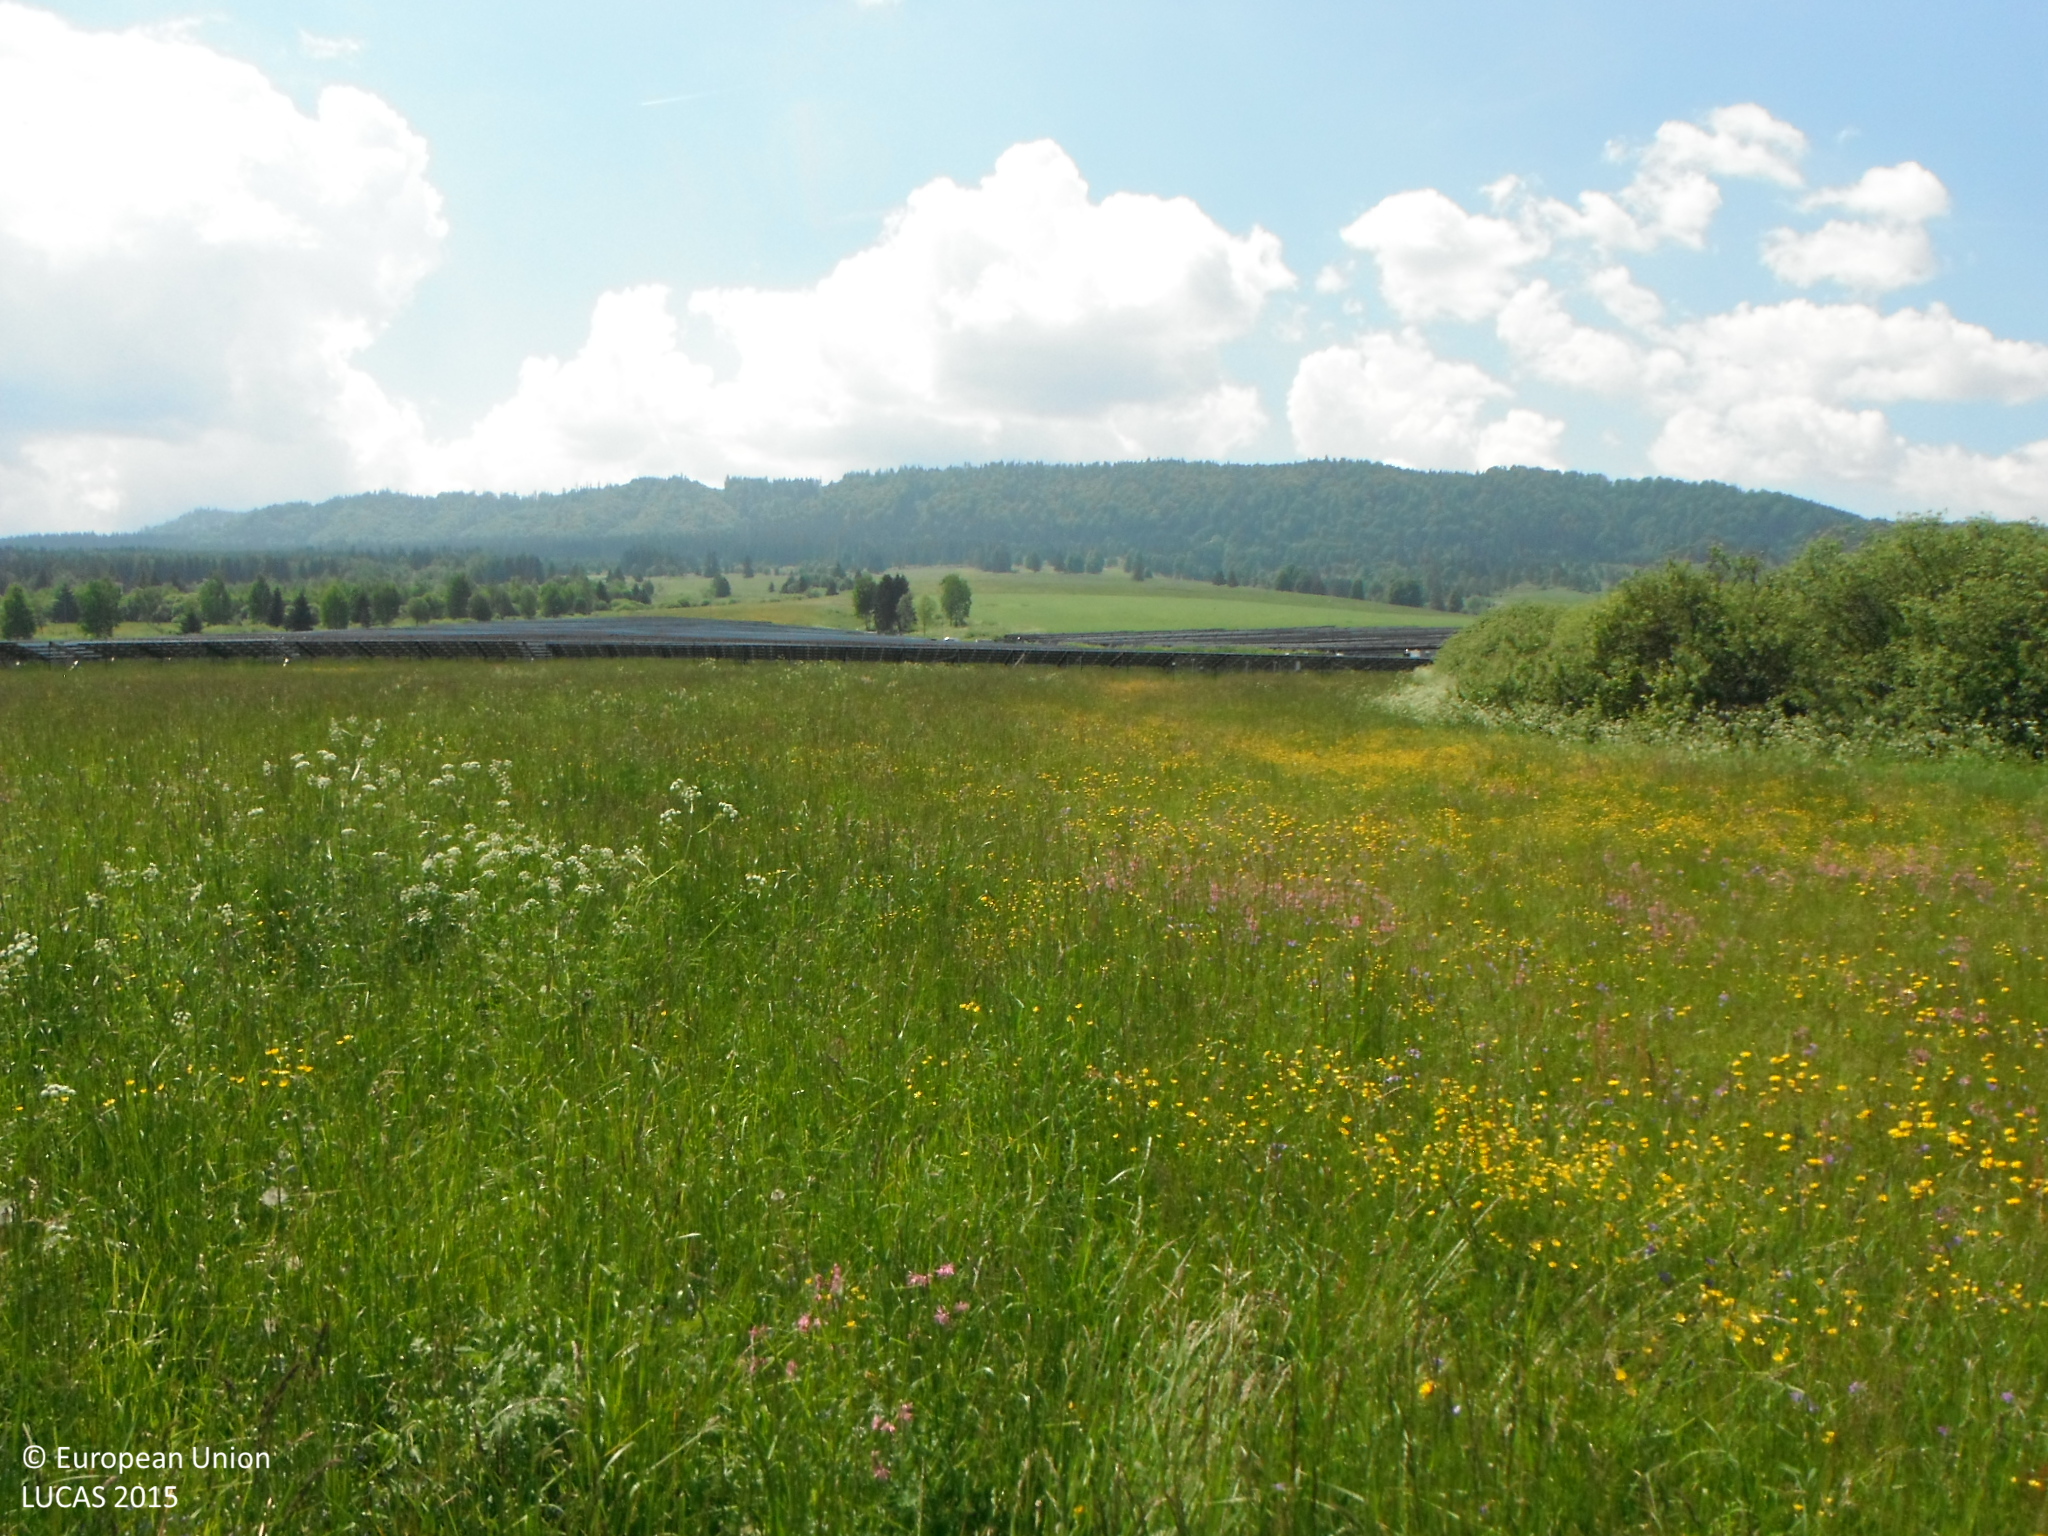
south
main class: Grassland
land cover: Grassland without tree/shrub cover
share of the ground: > 75 %
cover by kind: herbaceous plants 100 %
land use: Agriculture (excluding fallow land and kitchen gardens)
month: June
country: SK
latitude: 48.7910
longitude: 19.7054
